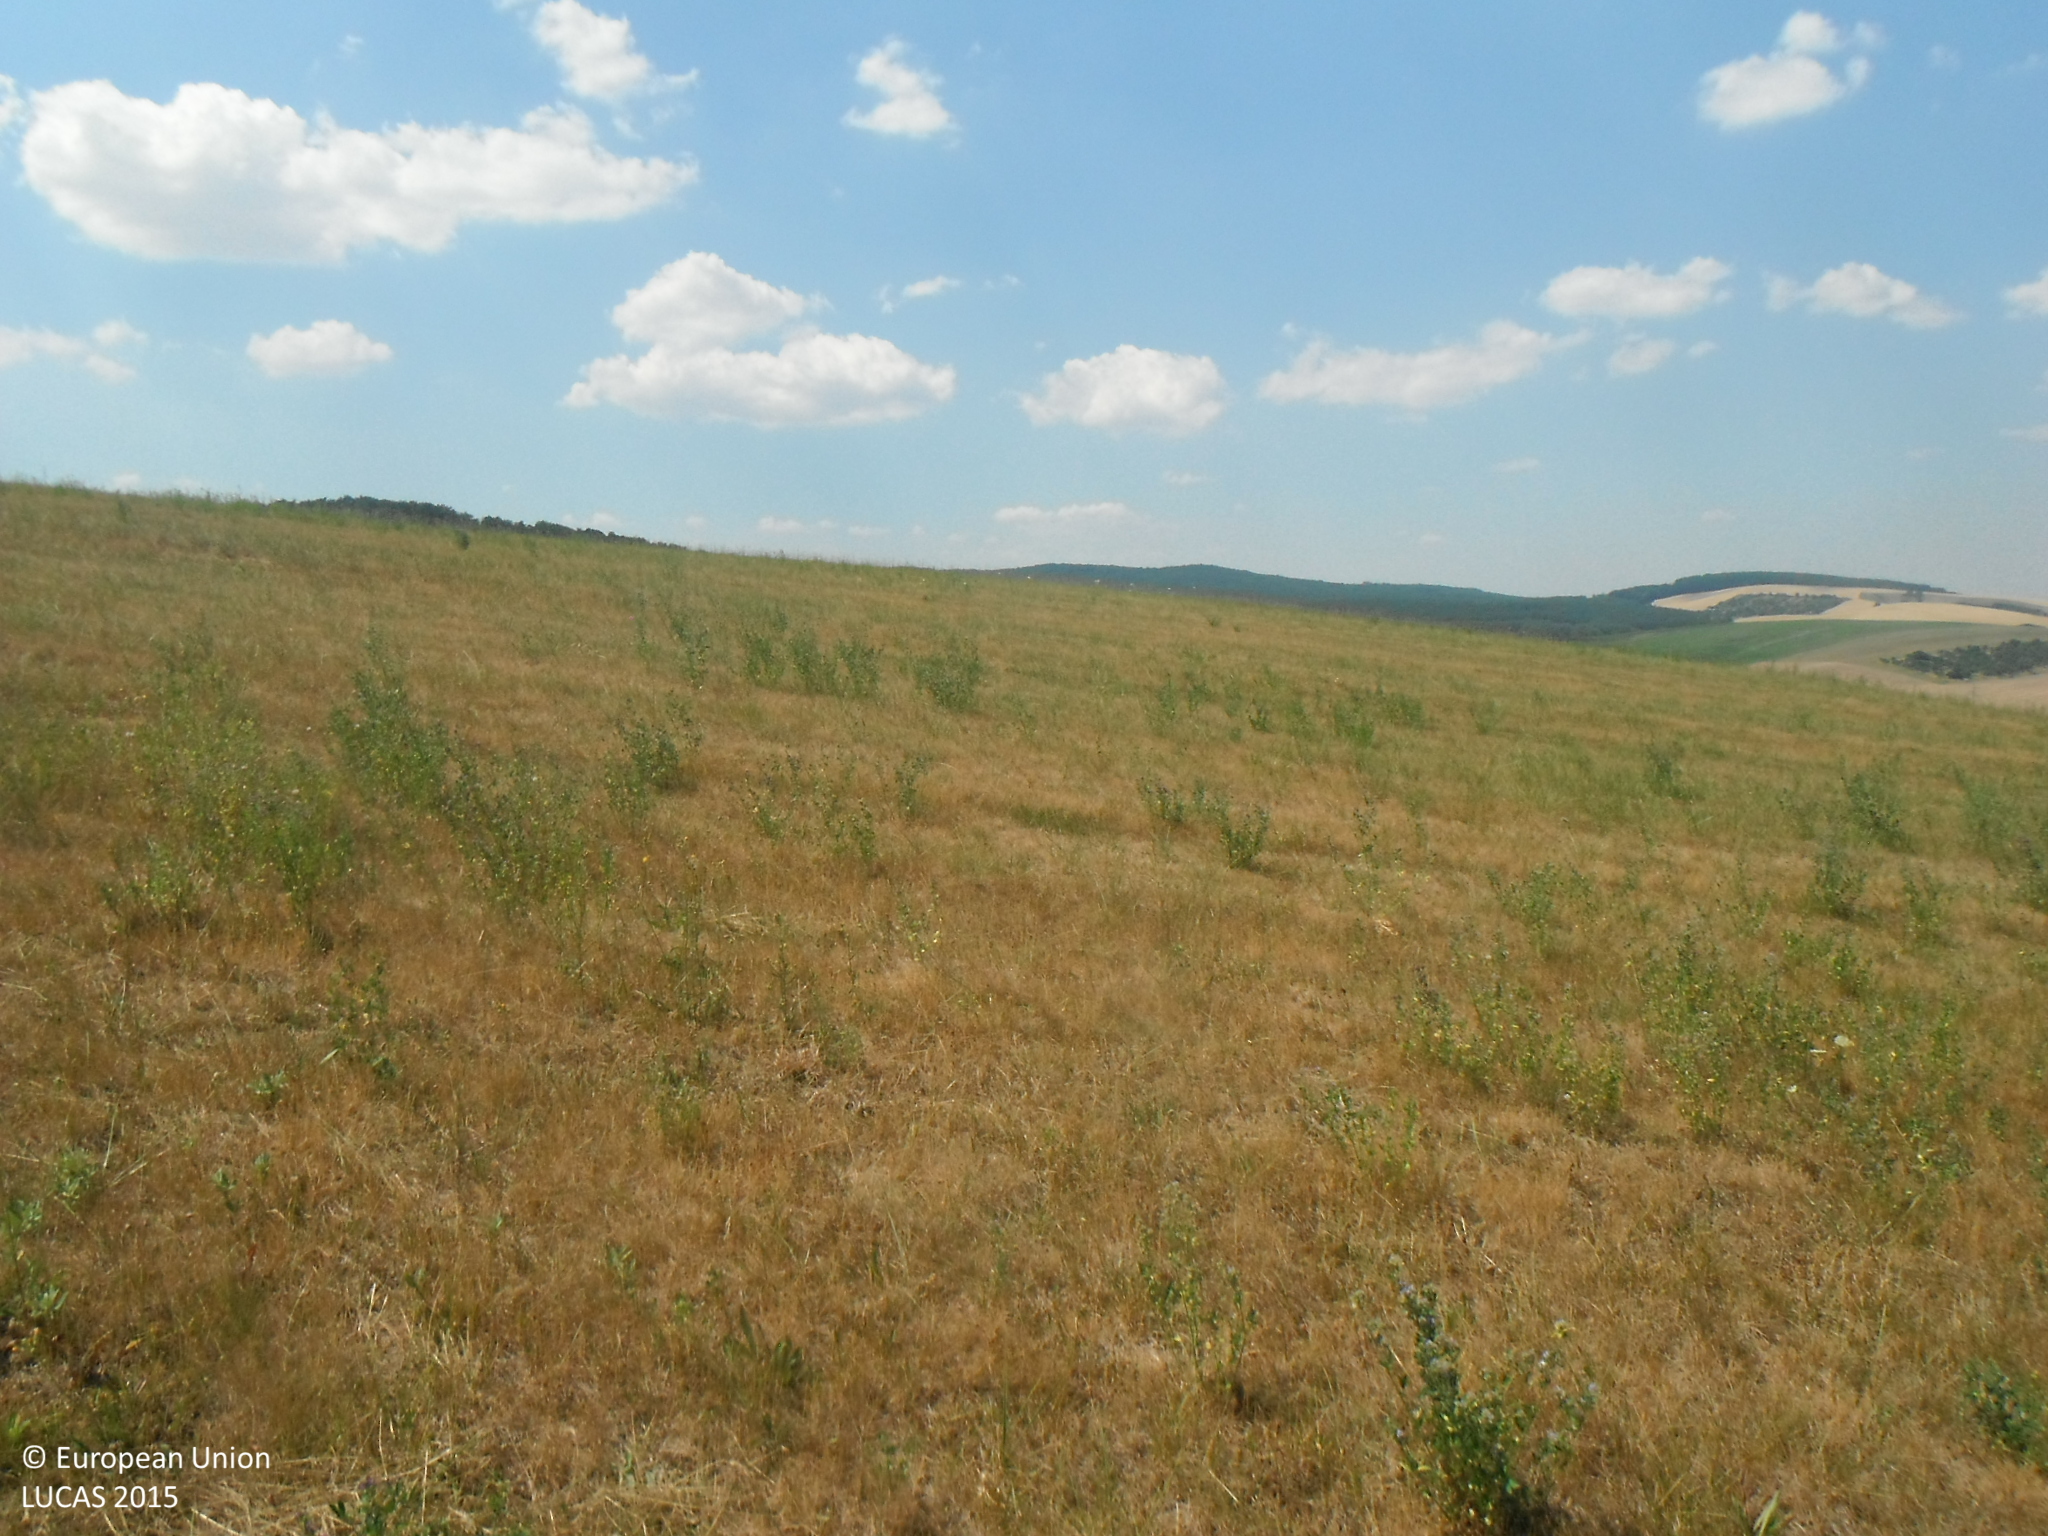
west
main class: Grassland
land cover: Grassland without tree/shrub cover
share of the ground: > 75 %
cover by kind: herbaceous plants 100 %
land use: Agriculture (excluding fallow land and kitchen gardens)
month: July
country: SK
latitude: 48.7393
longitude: 17.3121
